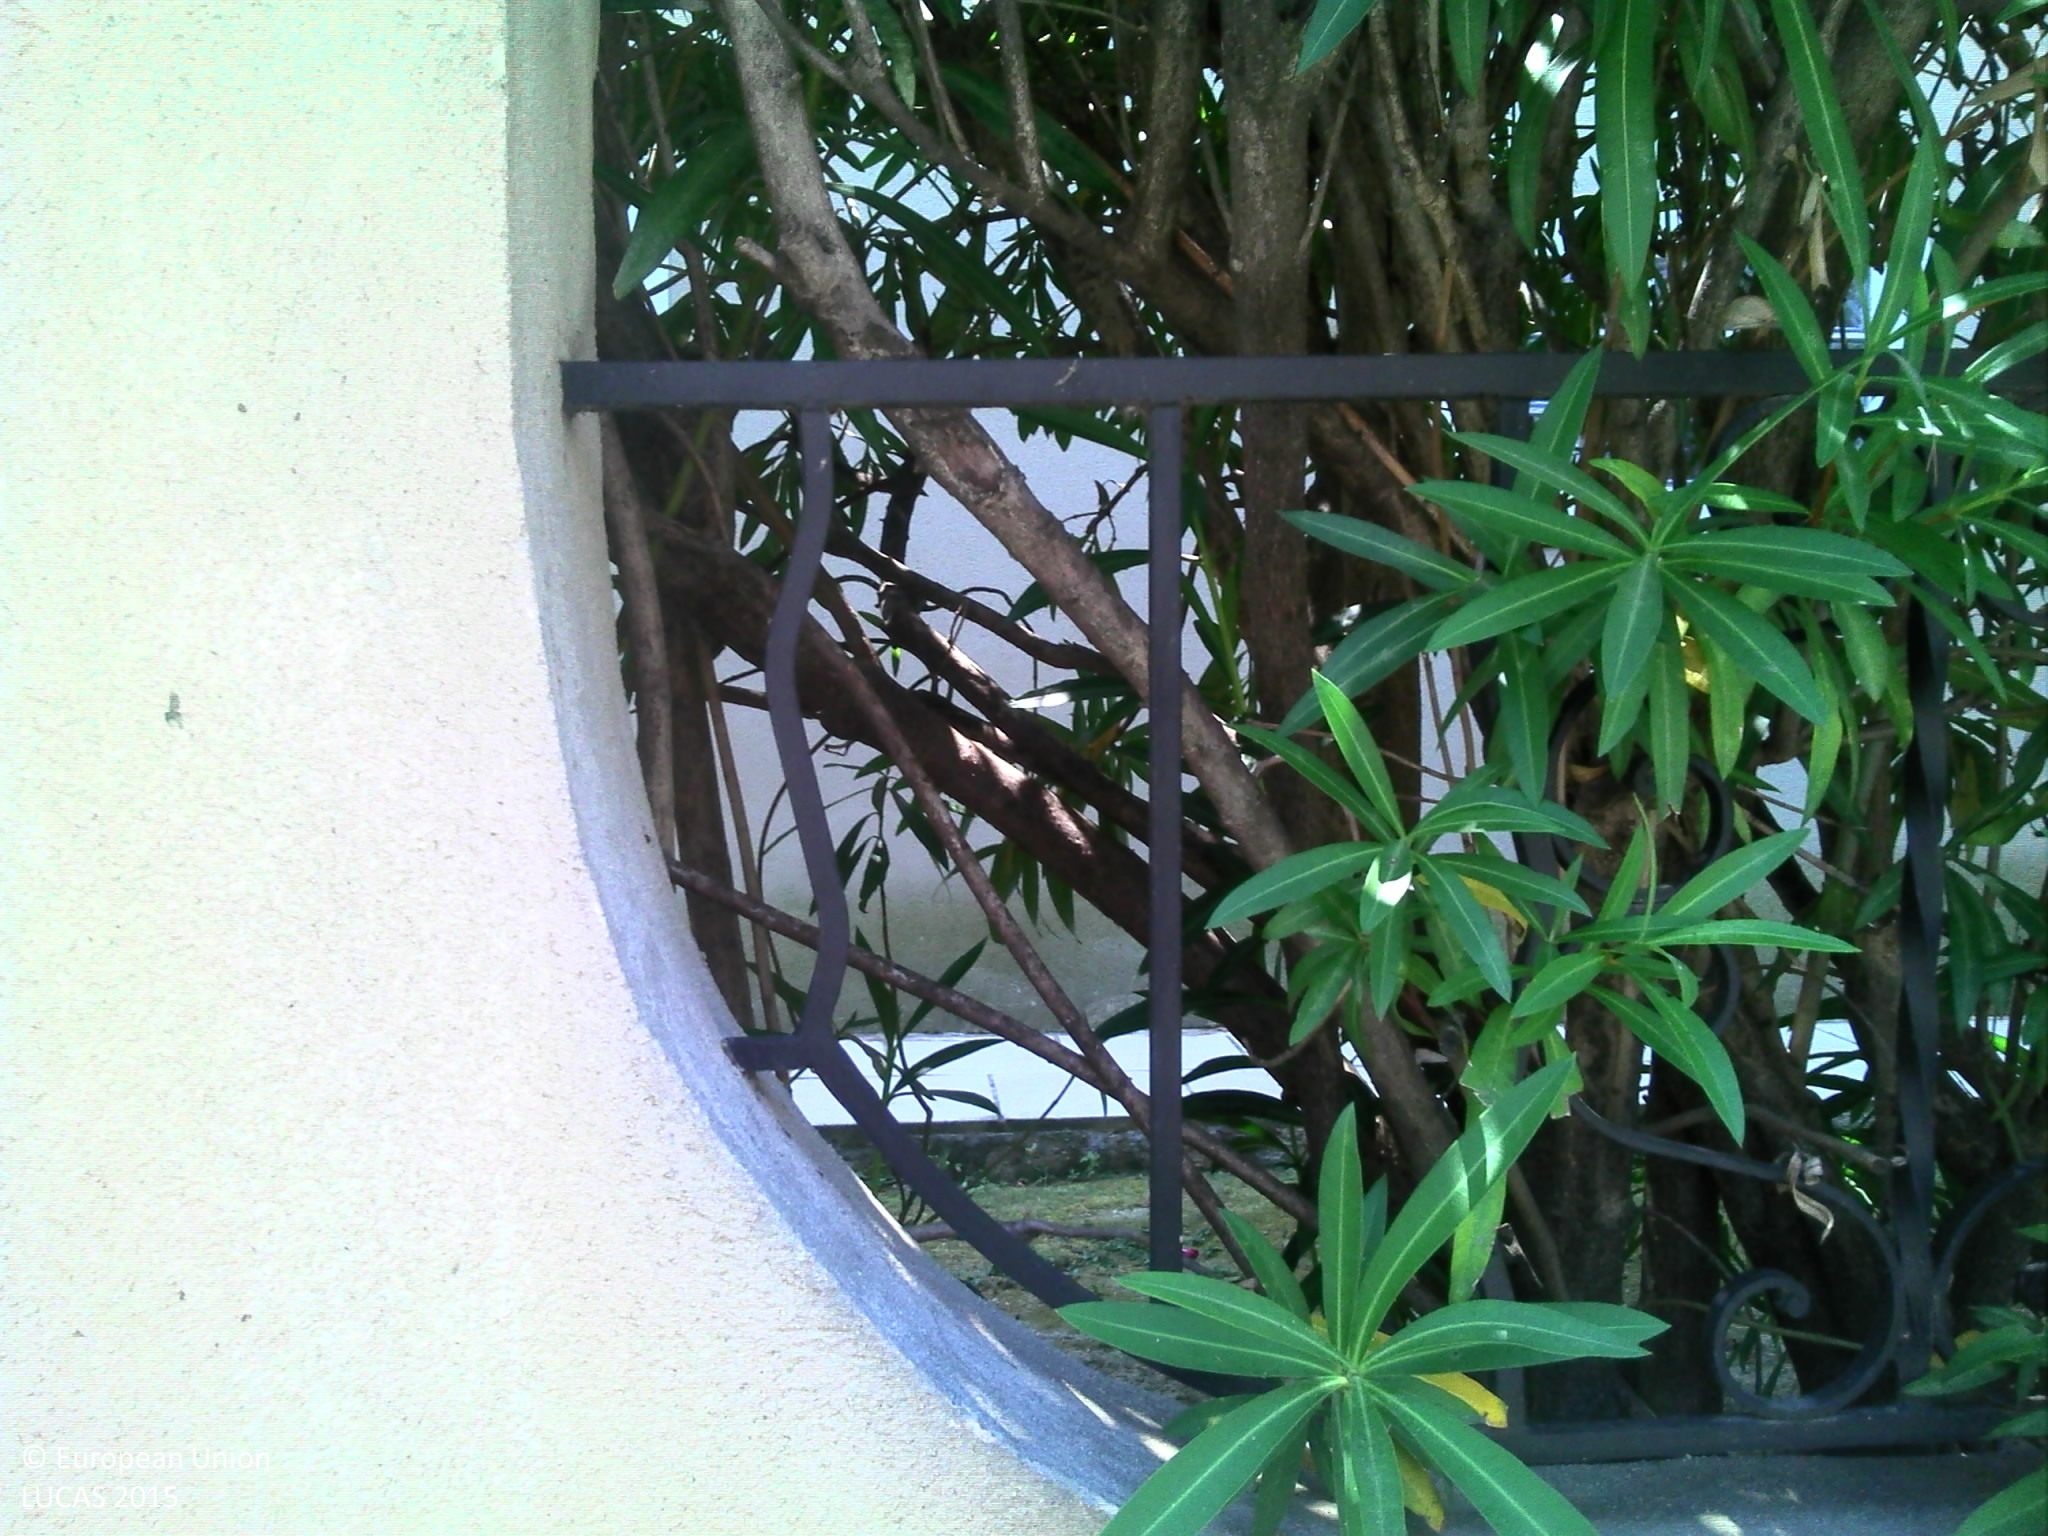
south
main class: Woodland
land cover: Pine dominated coniferous woodland
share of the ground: 25 - 50 %
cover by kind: coniferous forest trees 20 %, shrubs 10 %, herbaceous plants 10 %
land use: Residential
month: July
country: FR
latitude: 43.6391
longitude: 5.1131
